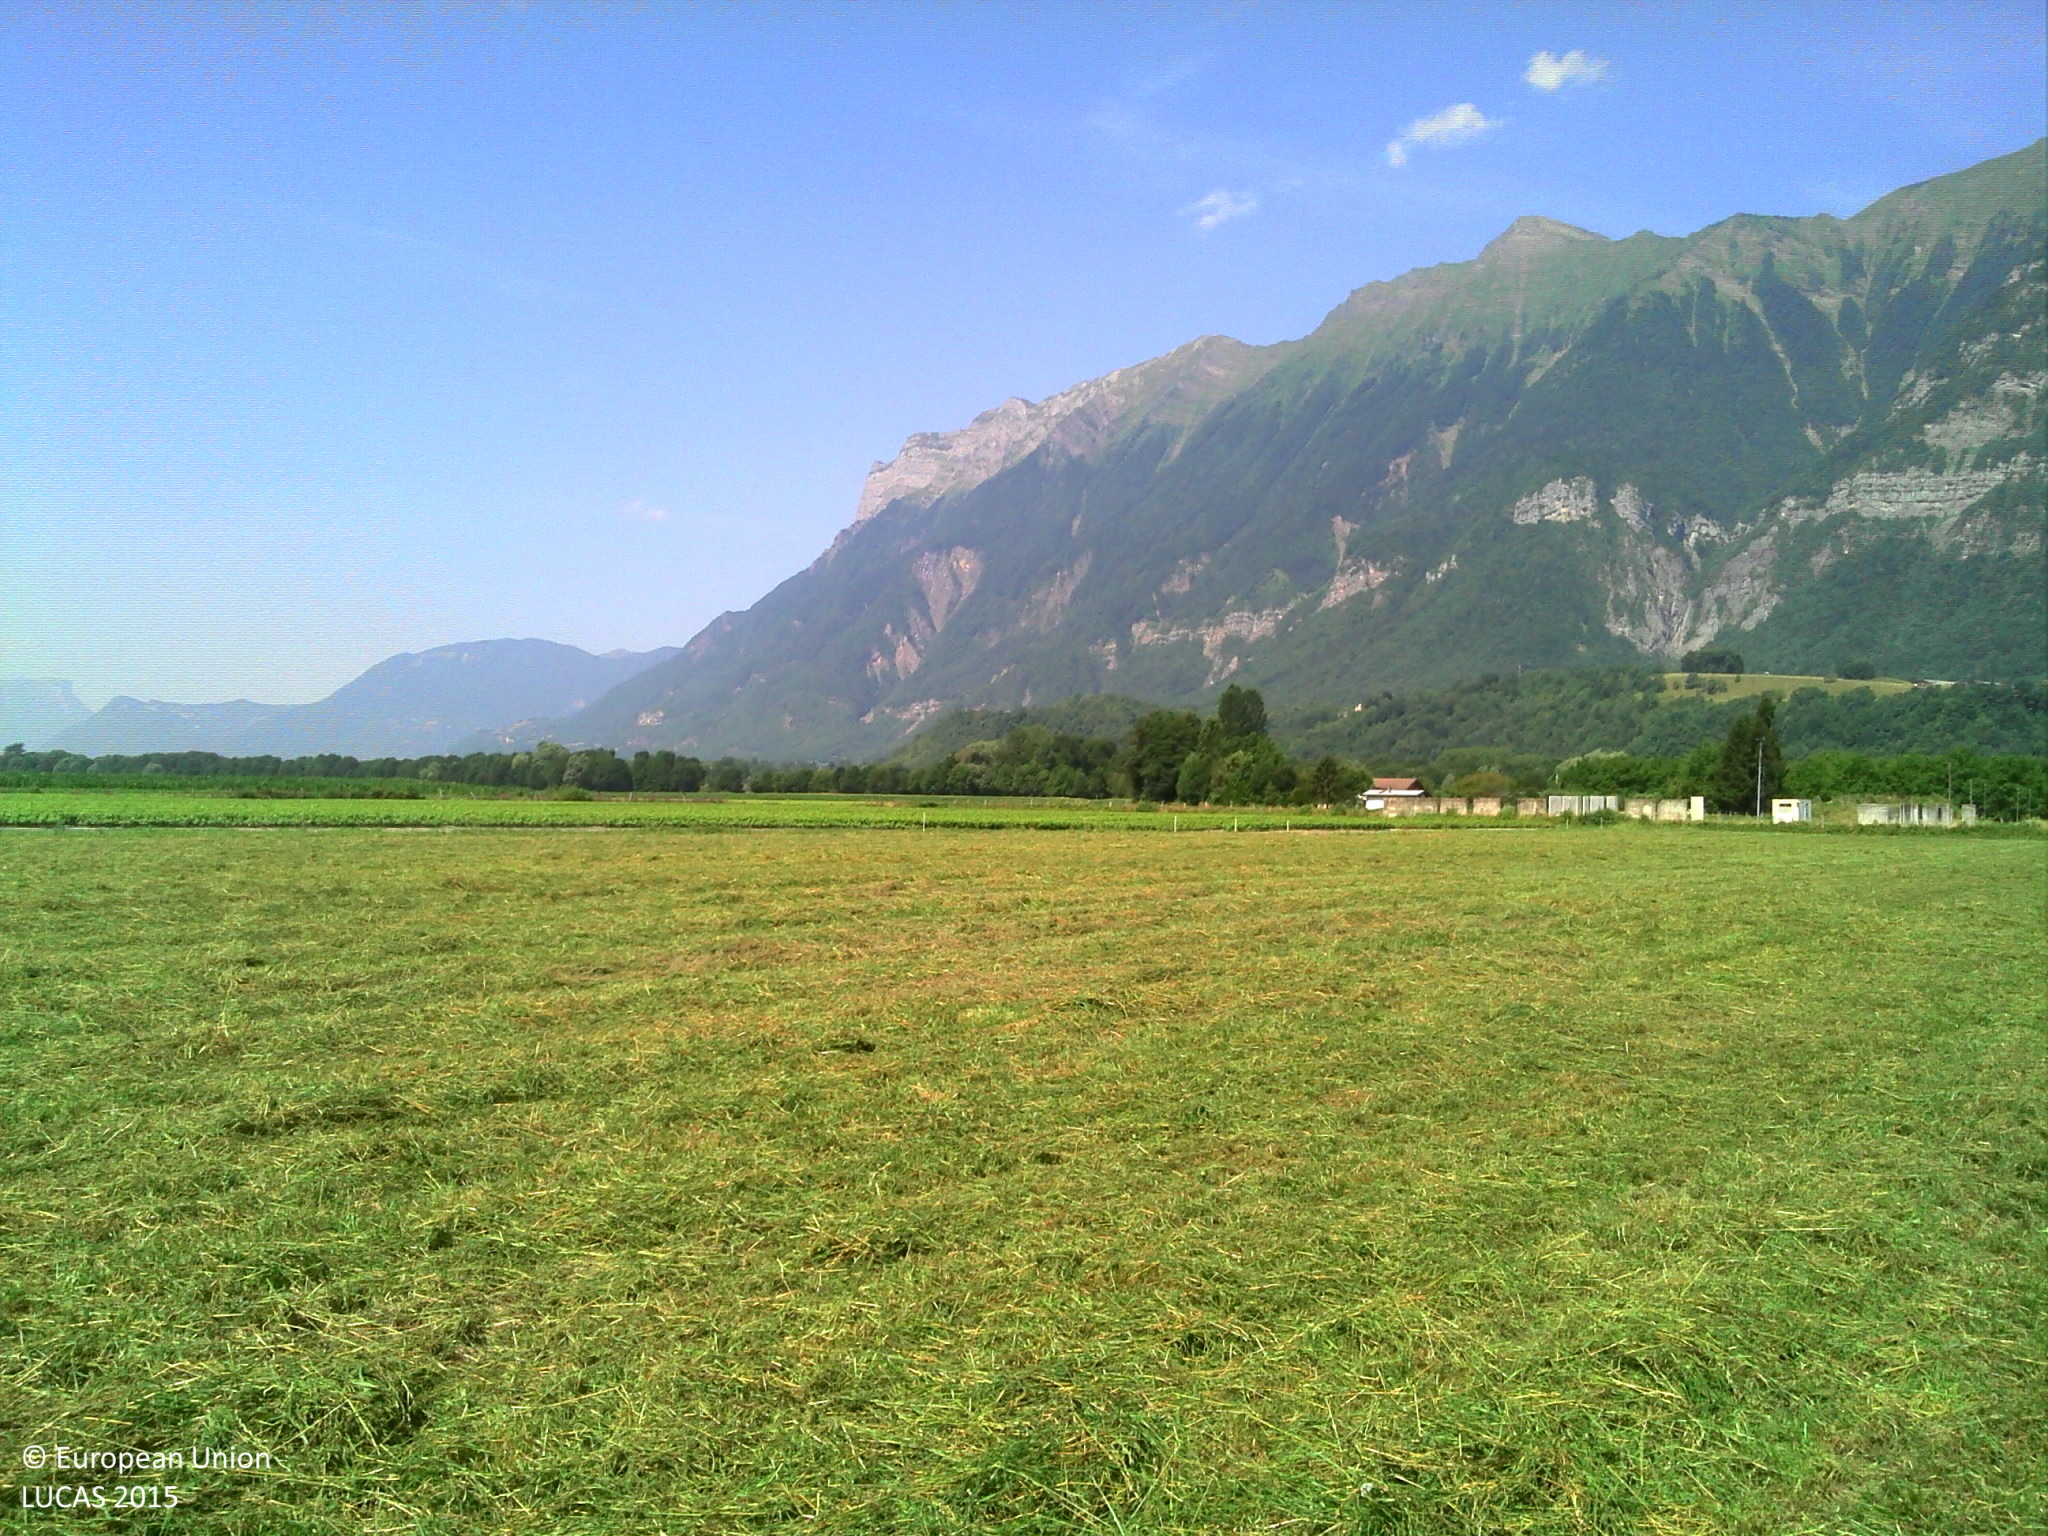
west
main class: Grassland
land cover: Grassland without tree/shrub cover
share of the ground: > 75 %
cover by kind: herbaceous plants 100 %
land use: Agriculture (excluding fallow land and kitchen gardens)
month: July
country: FR
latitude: 45.6019
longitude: 6.2993
